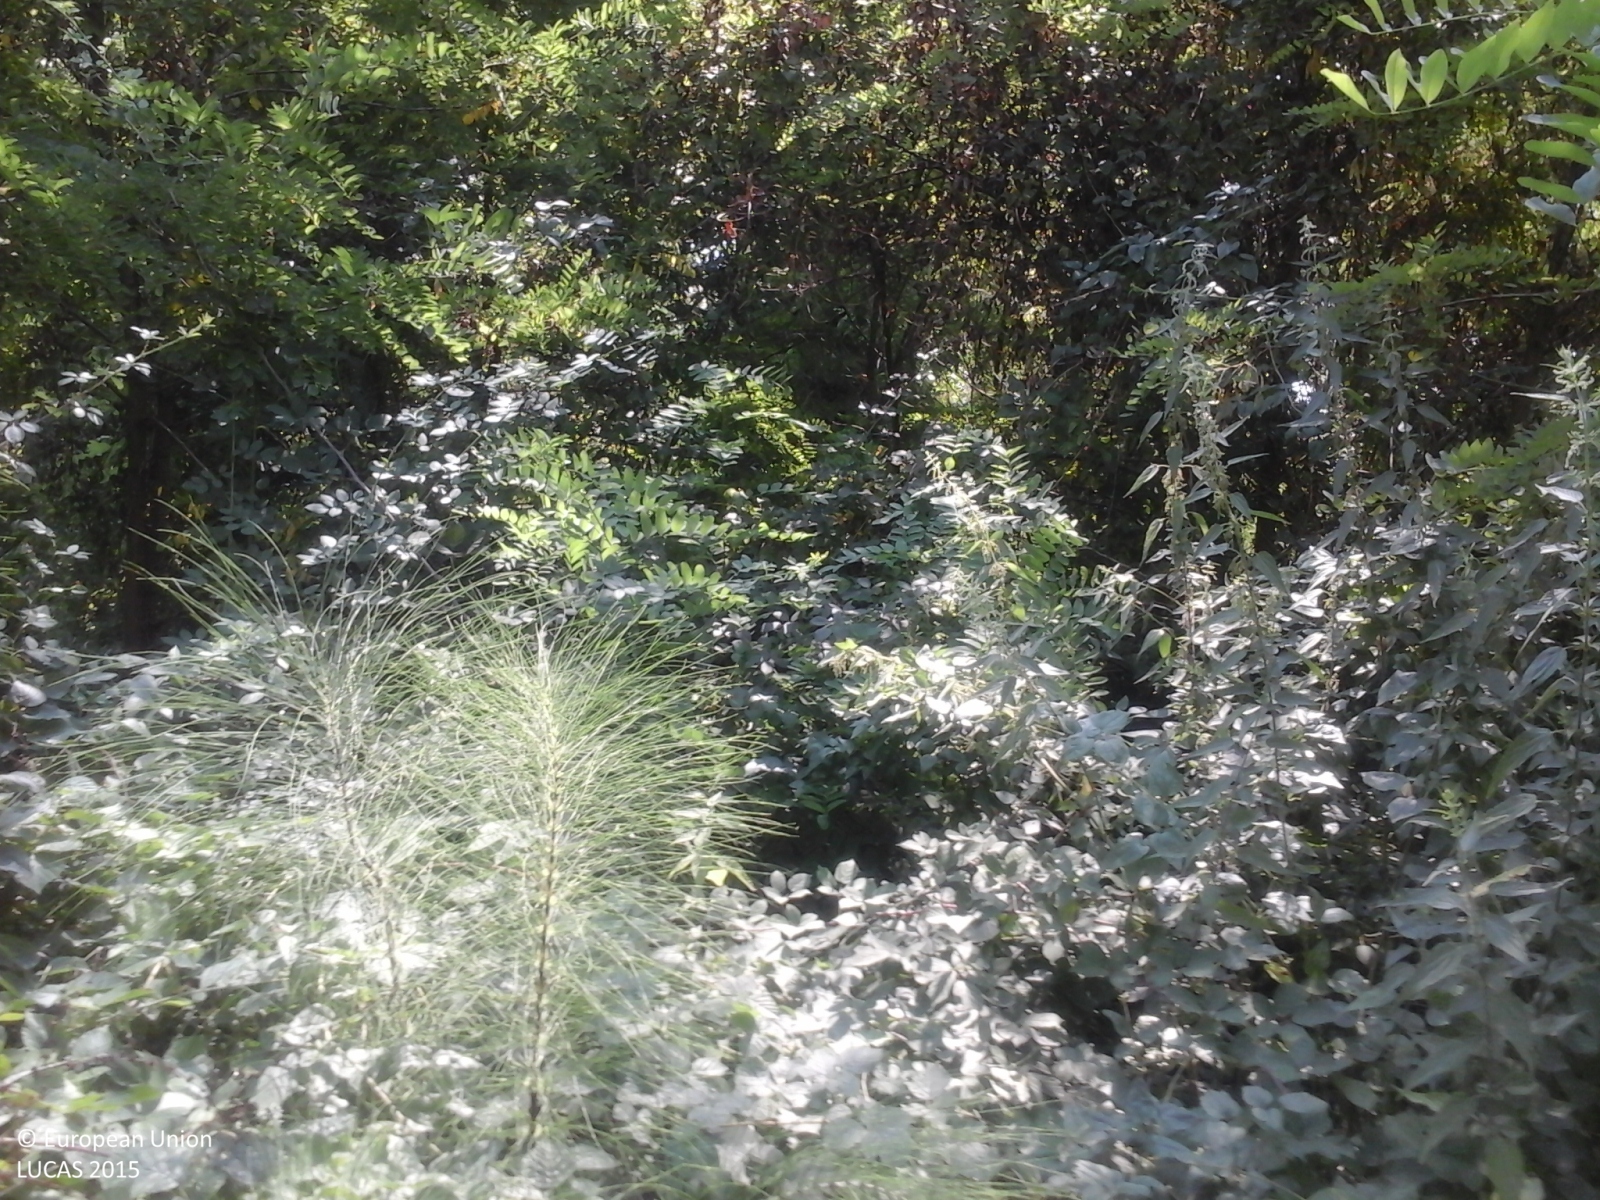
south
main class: Woodland
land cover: Broadleaved woodland
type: thermophilous deciduous forest
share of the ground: > 75 %
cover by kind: broadleaved forest trees 100 %
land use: Forestry
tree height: > 5 m
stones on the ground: < 10 %
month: August
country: IT
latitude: 43.8526
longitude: 12.4448
